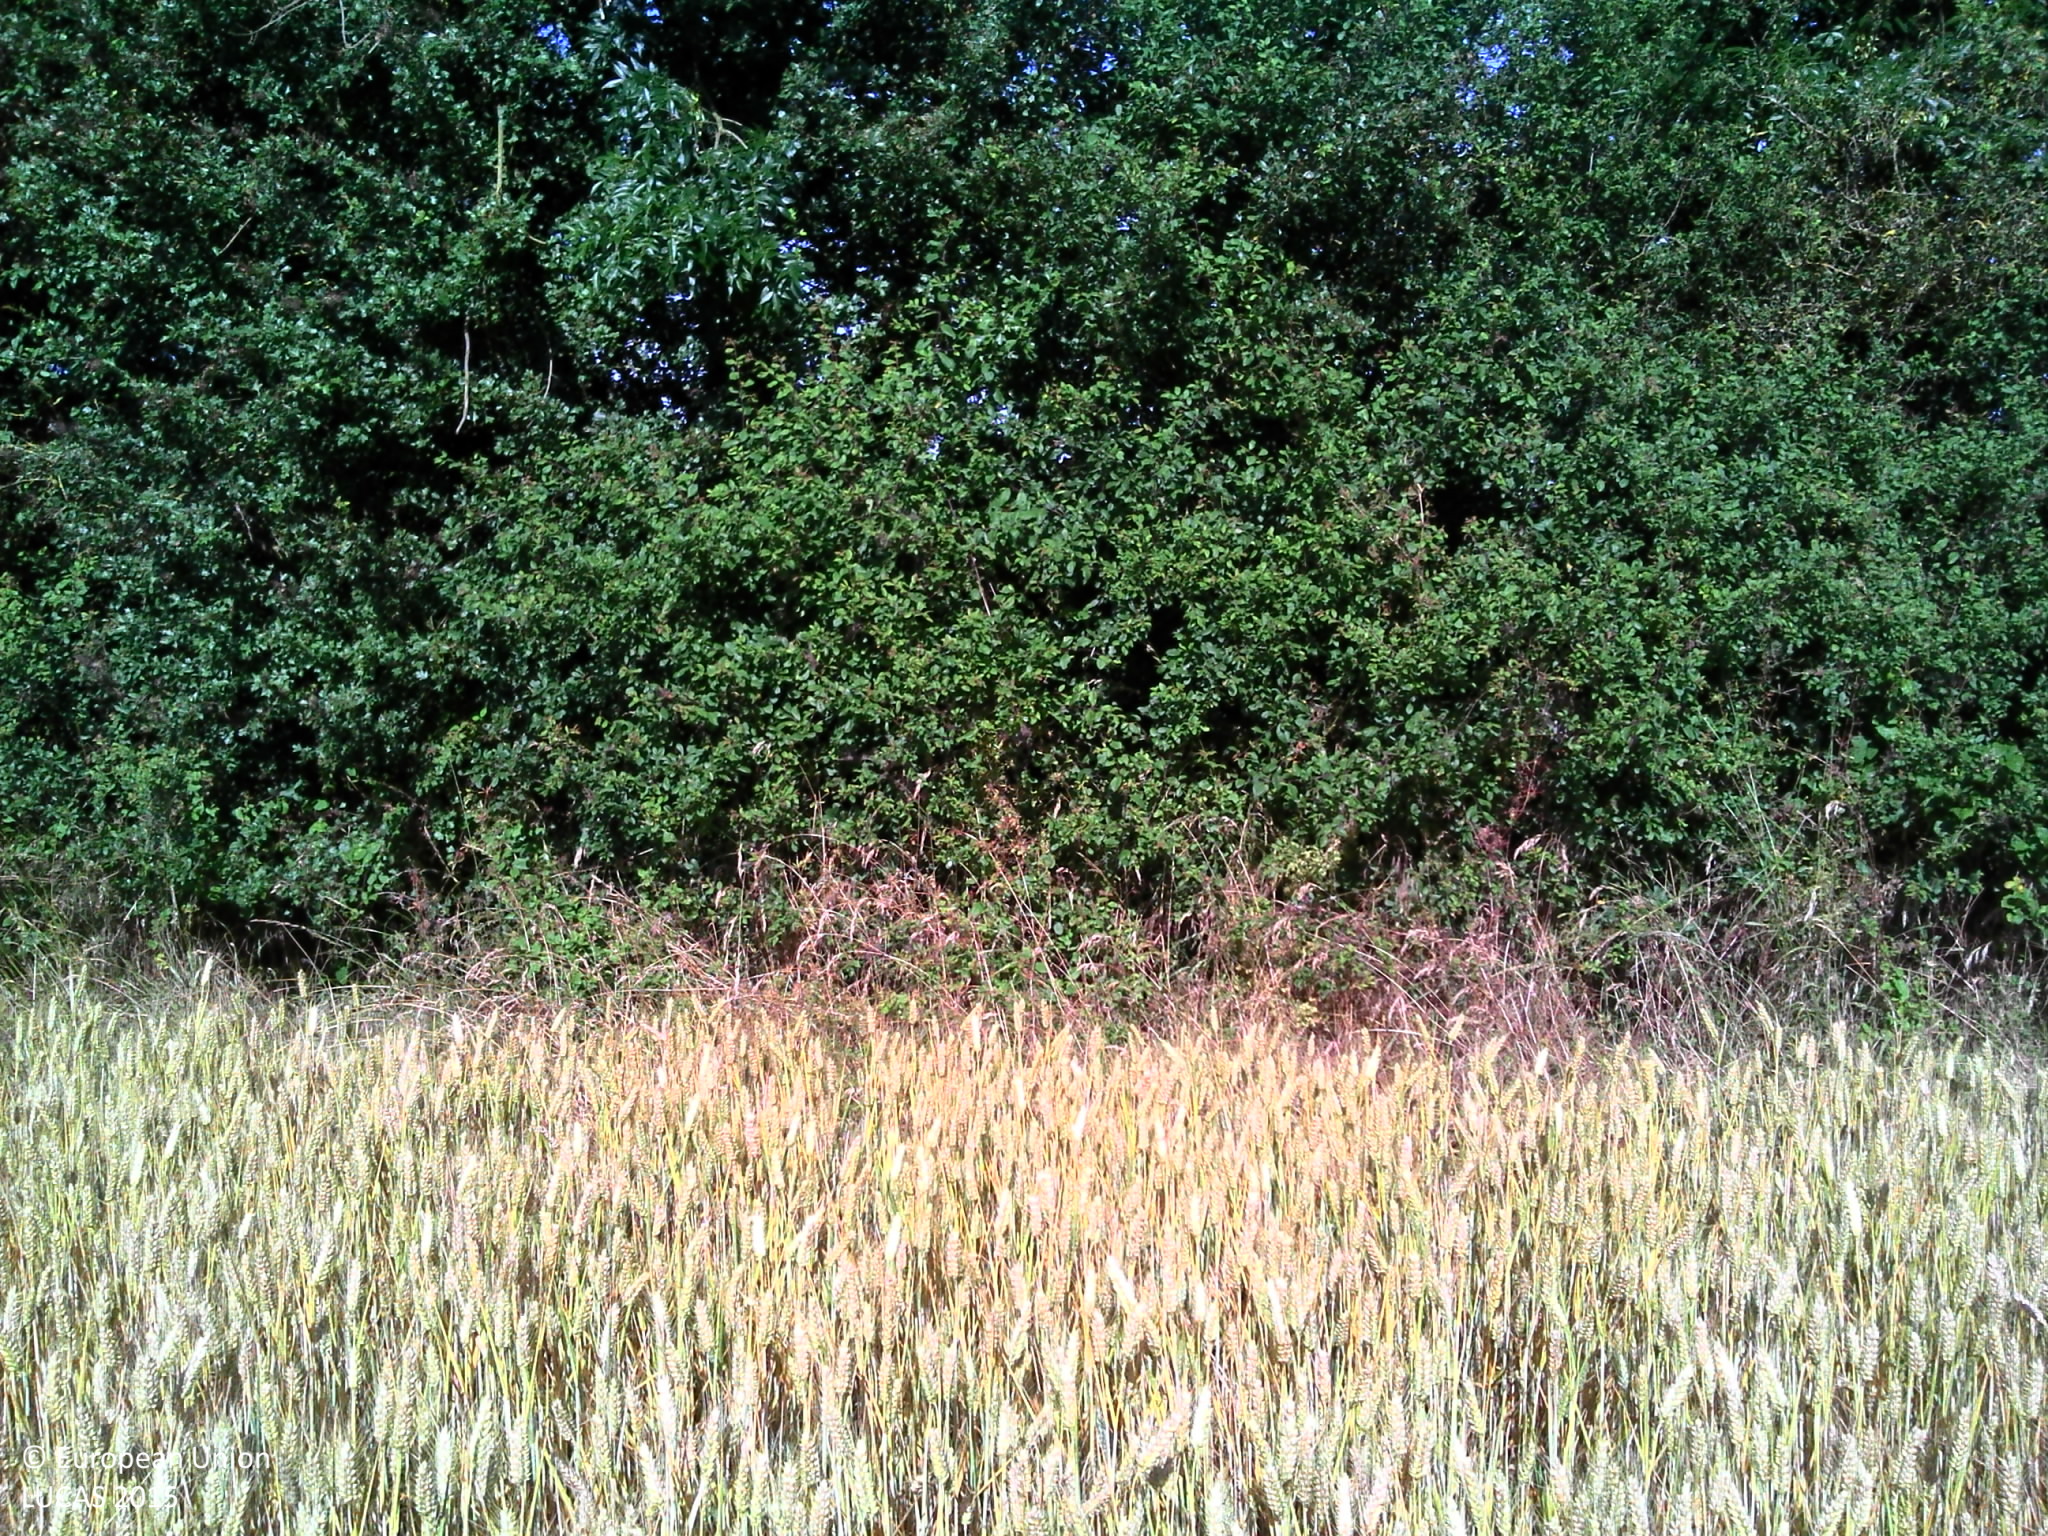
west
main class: Cropland
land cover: Common wheat
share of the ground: > 75 %
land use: Agriculture (excluding fallow land and kitchen gardens)
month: June
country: FR
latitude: 47.2494
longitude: -2.0594
